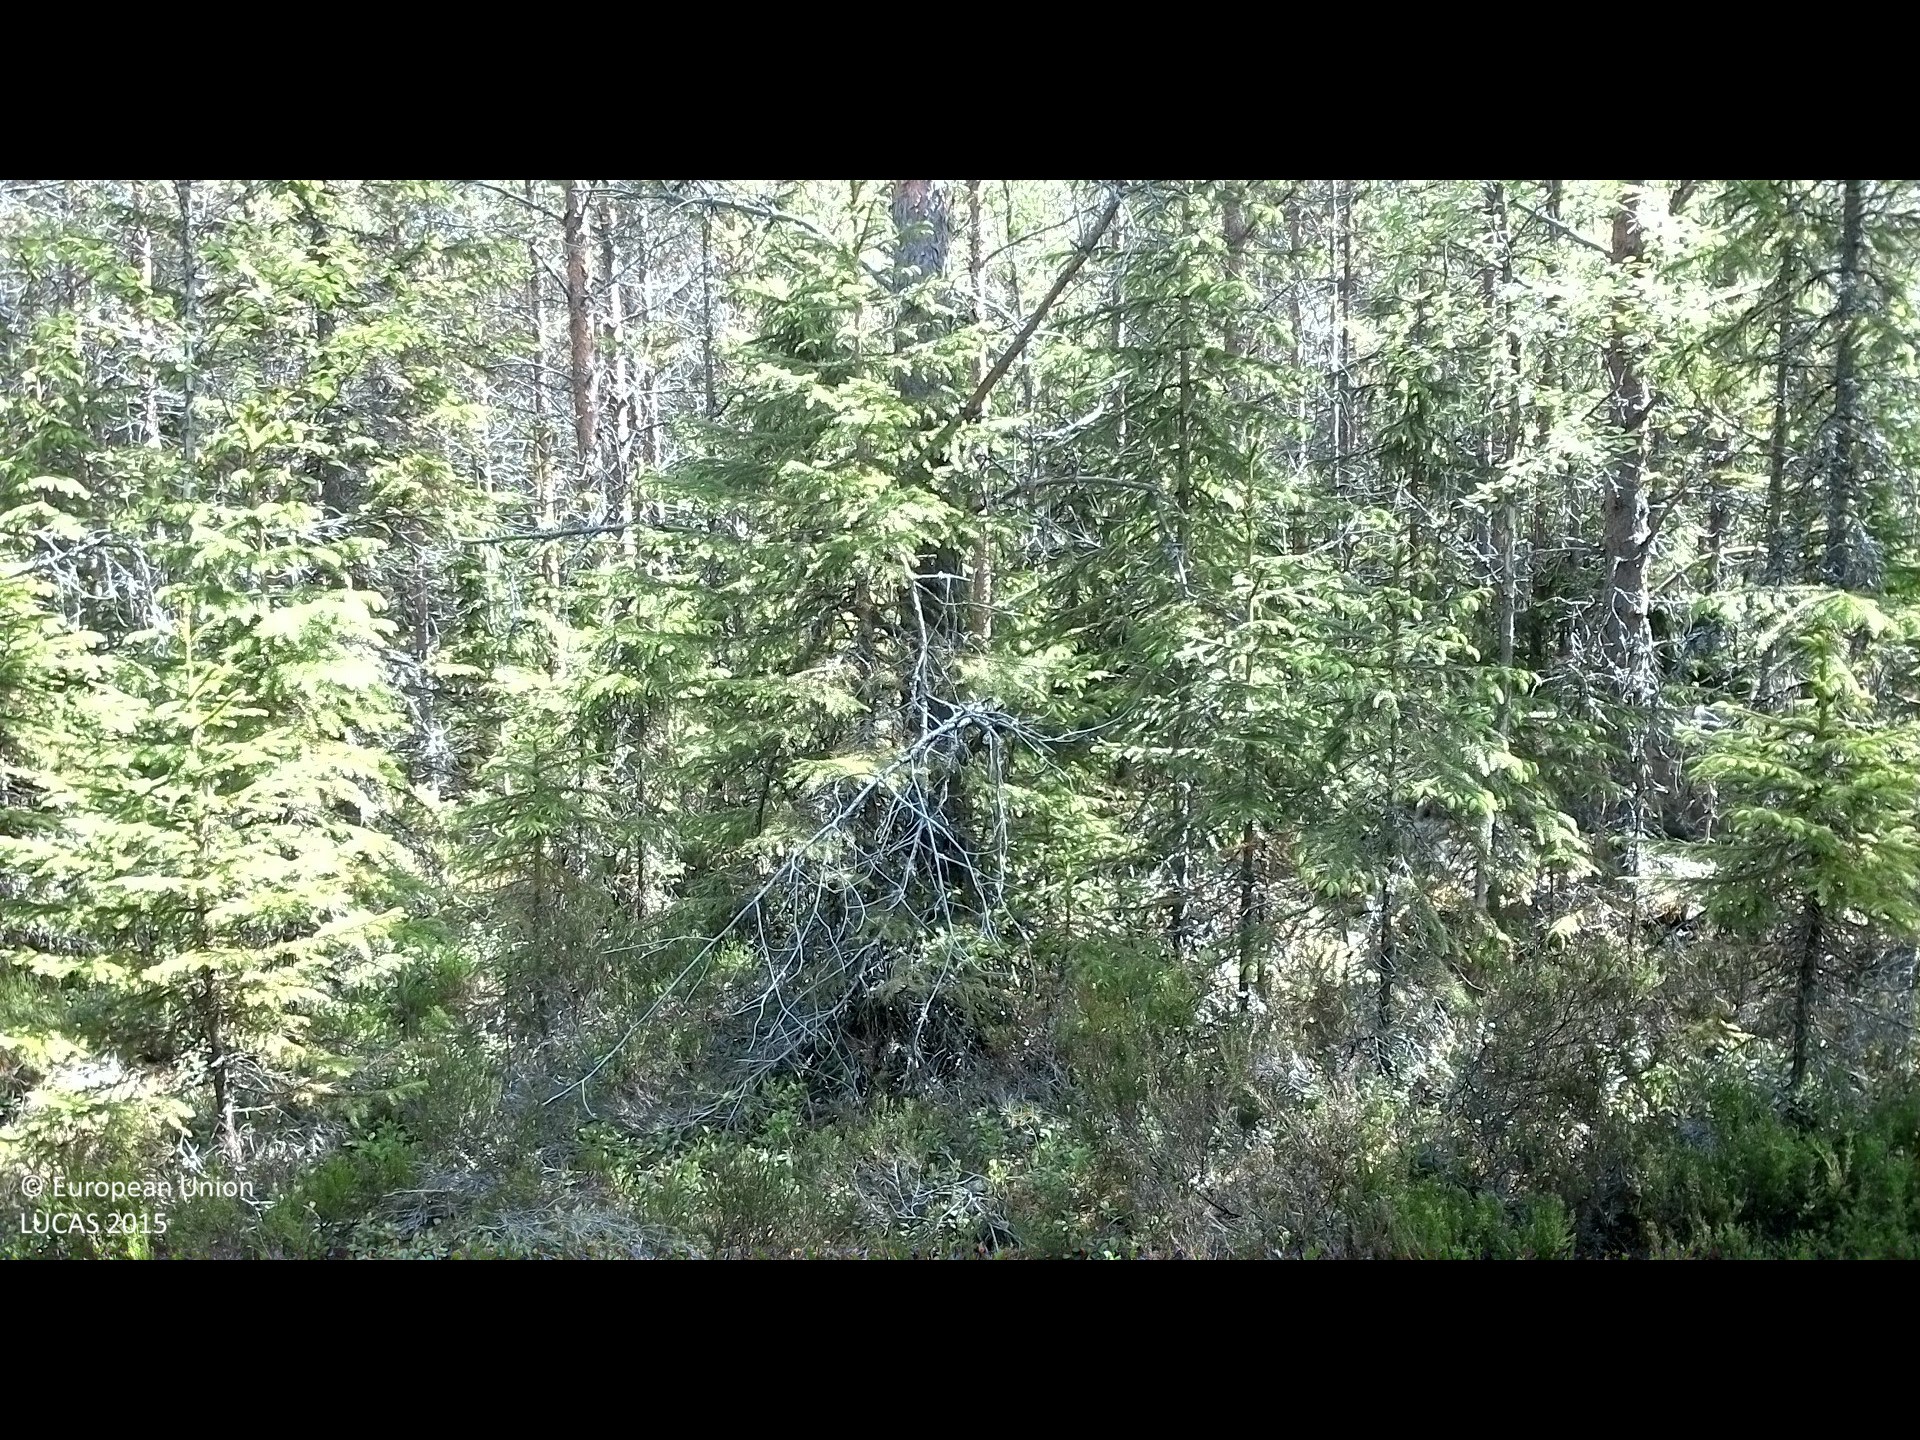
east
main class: Woodland
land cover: Other coniferous woodland
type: boreal forest
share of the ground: 50 - 75 %
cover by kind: coniferous forest trees 45 %, shrubs 30 %, lichens and mosses 15 %, broadleaved forest trees 10 %
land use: Forestry
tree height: > 5 m
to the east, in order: Other coniferous woodland; Pine dominated mixed woodland; Pine dominated coniferous woodland; Ditches and canals; Paved roads, cycling and walking lanes; Ditches and canals; Spruce dominated coniferous woodland; Other mixed woodland; Pine dominated mixed woodland
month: June
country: SE
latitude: 62.2041
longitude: 17.5749
